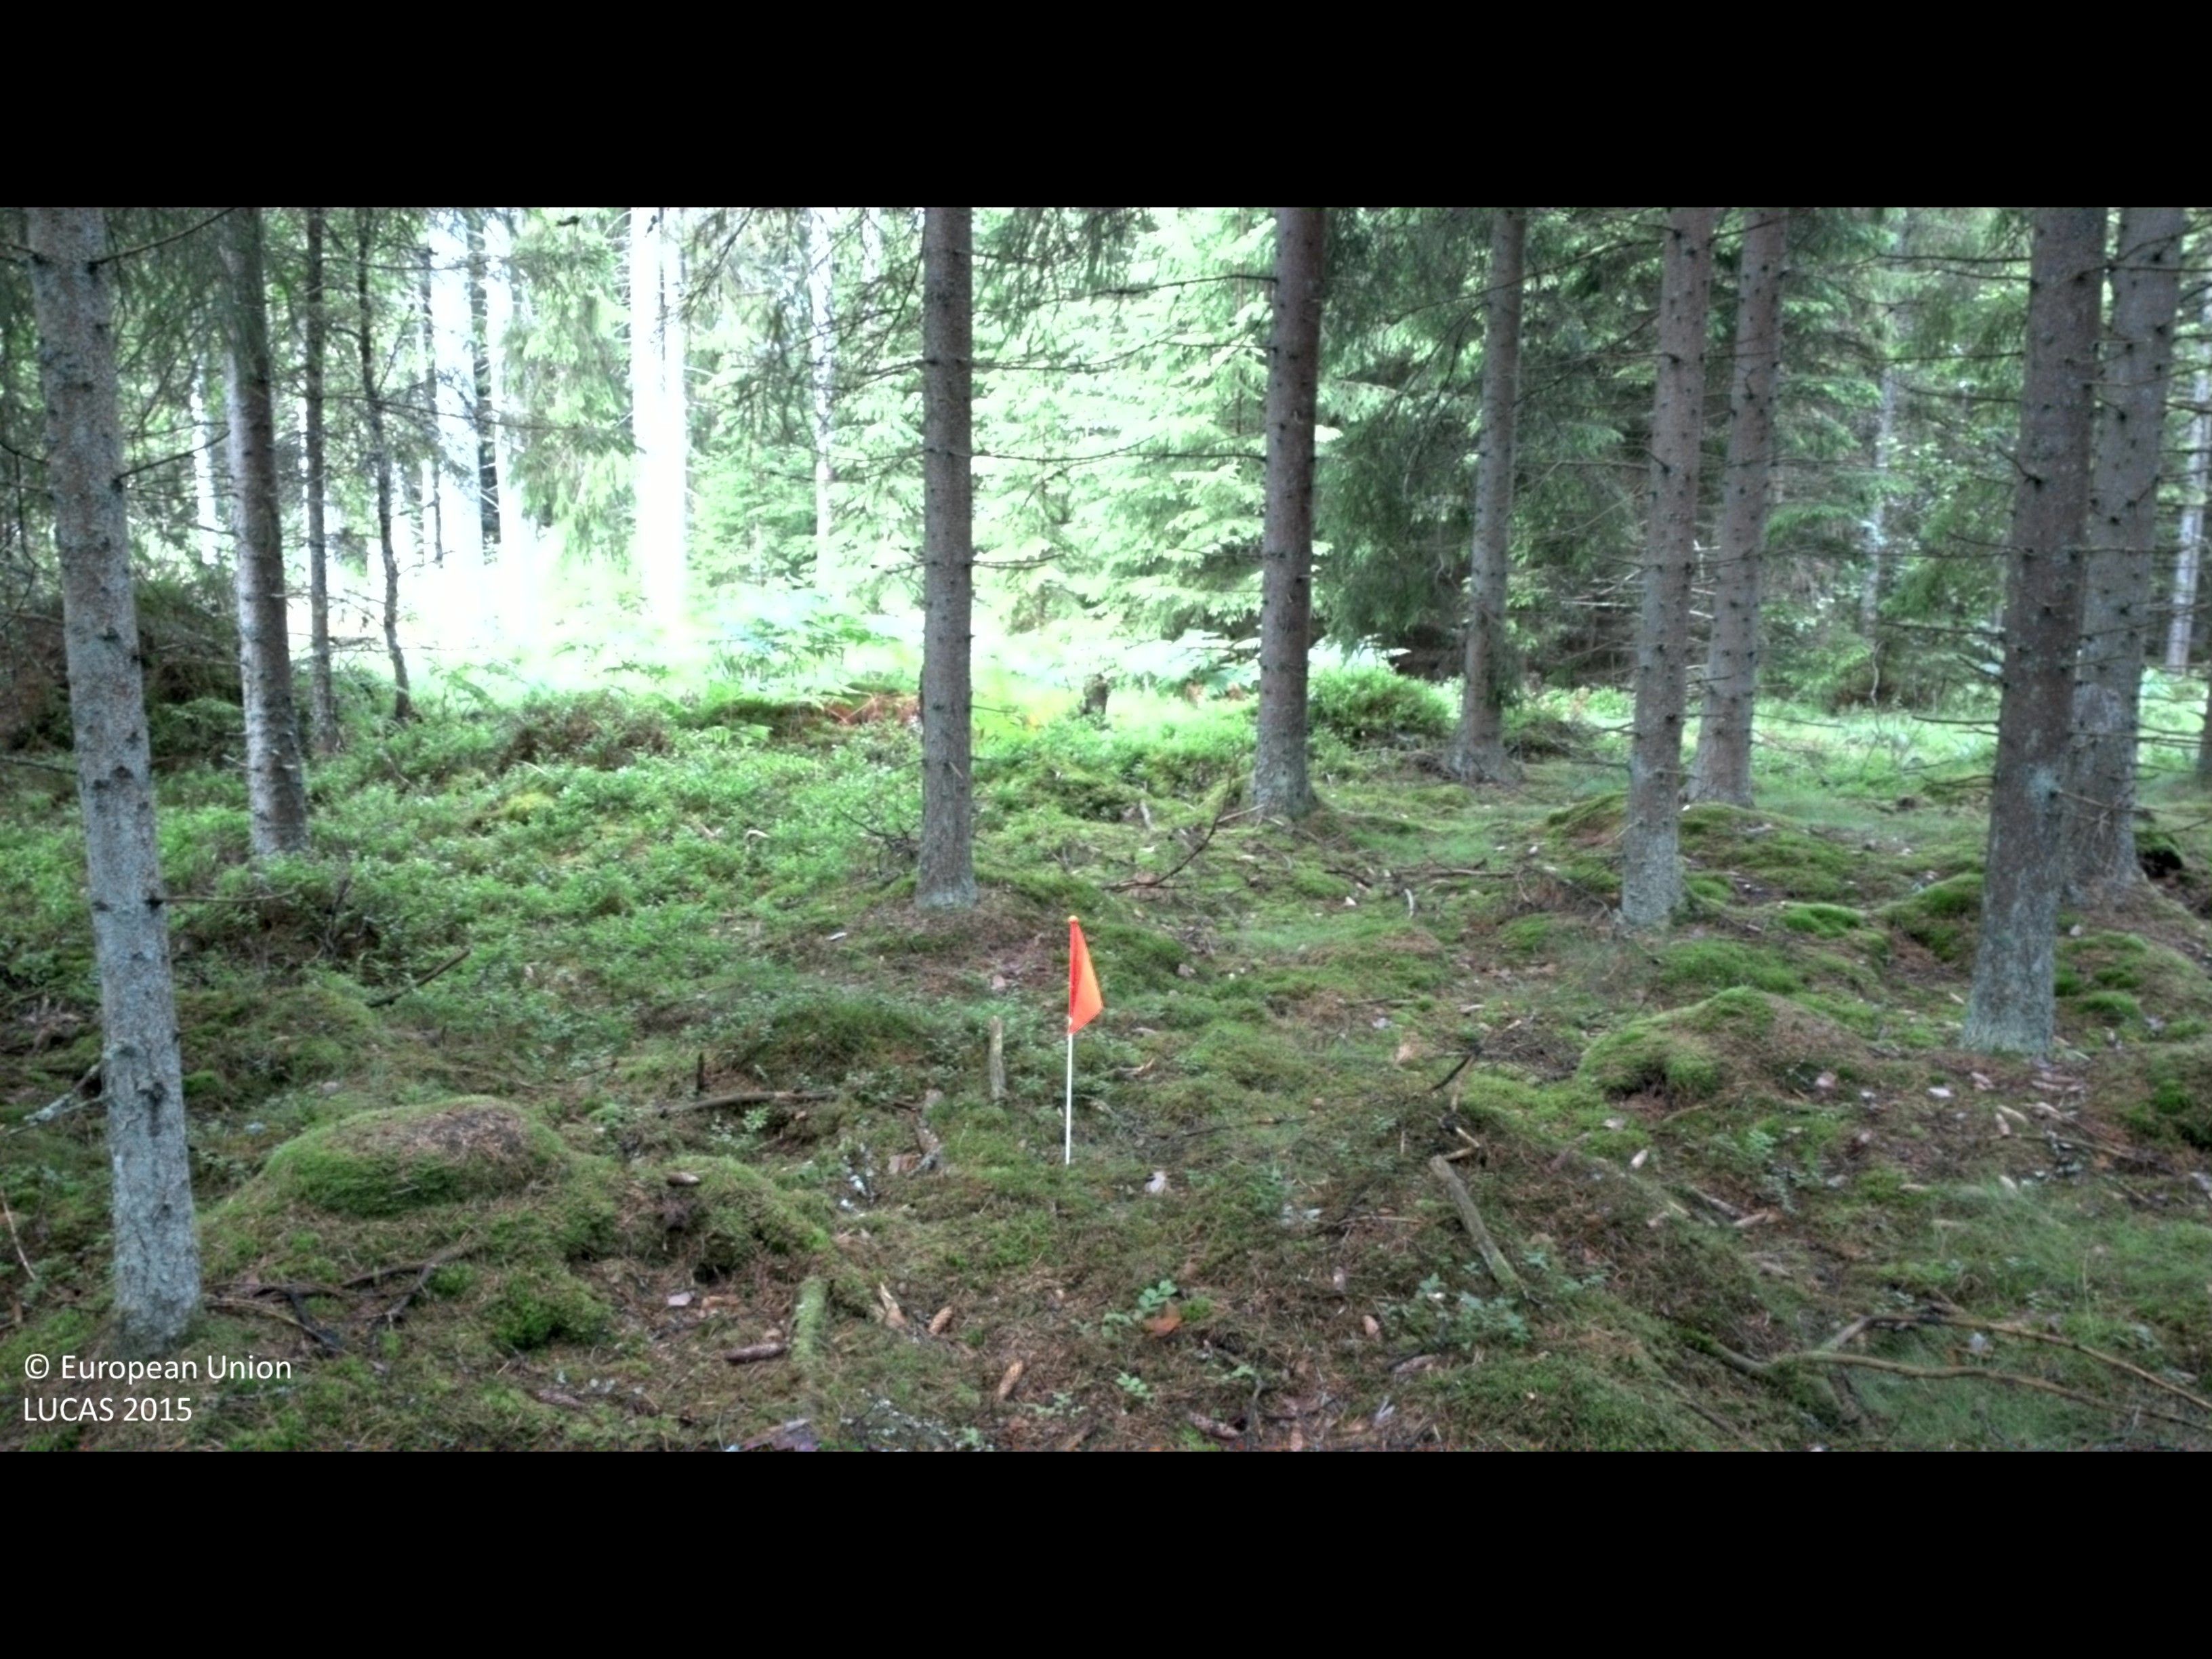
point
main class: Woodland
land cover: Spruce dominated coniferous woodland
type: boreal forest
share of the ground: 50 - 75 %
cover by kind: coniferous forest trees 75 %, shrubs 20 %, lichens and mosses 5 %
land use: Forestry
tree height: > 5 m
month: July
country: SE
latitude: 56.6215
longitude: 14.2507
